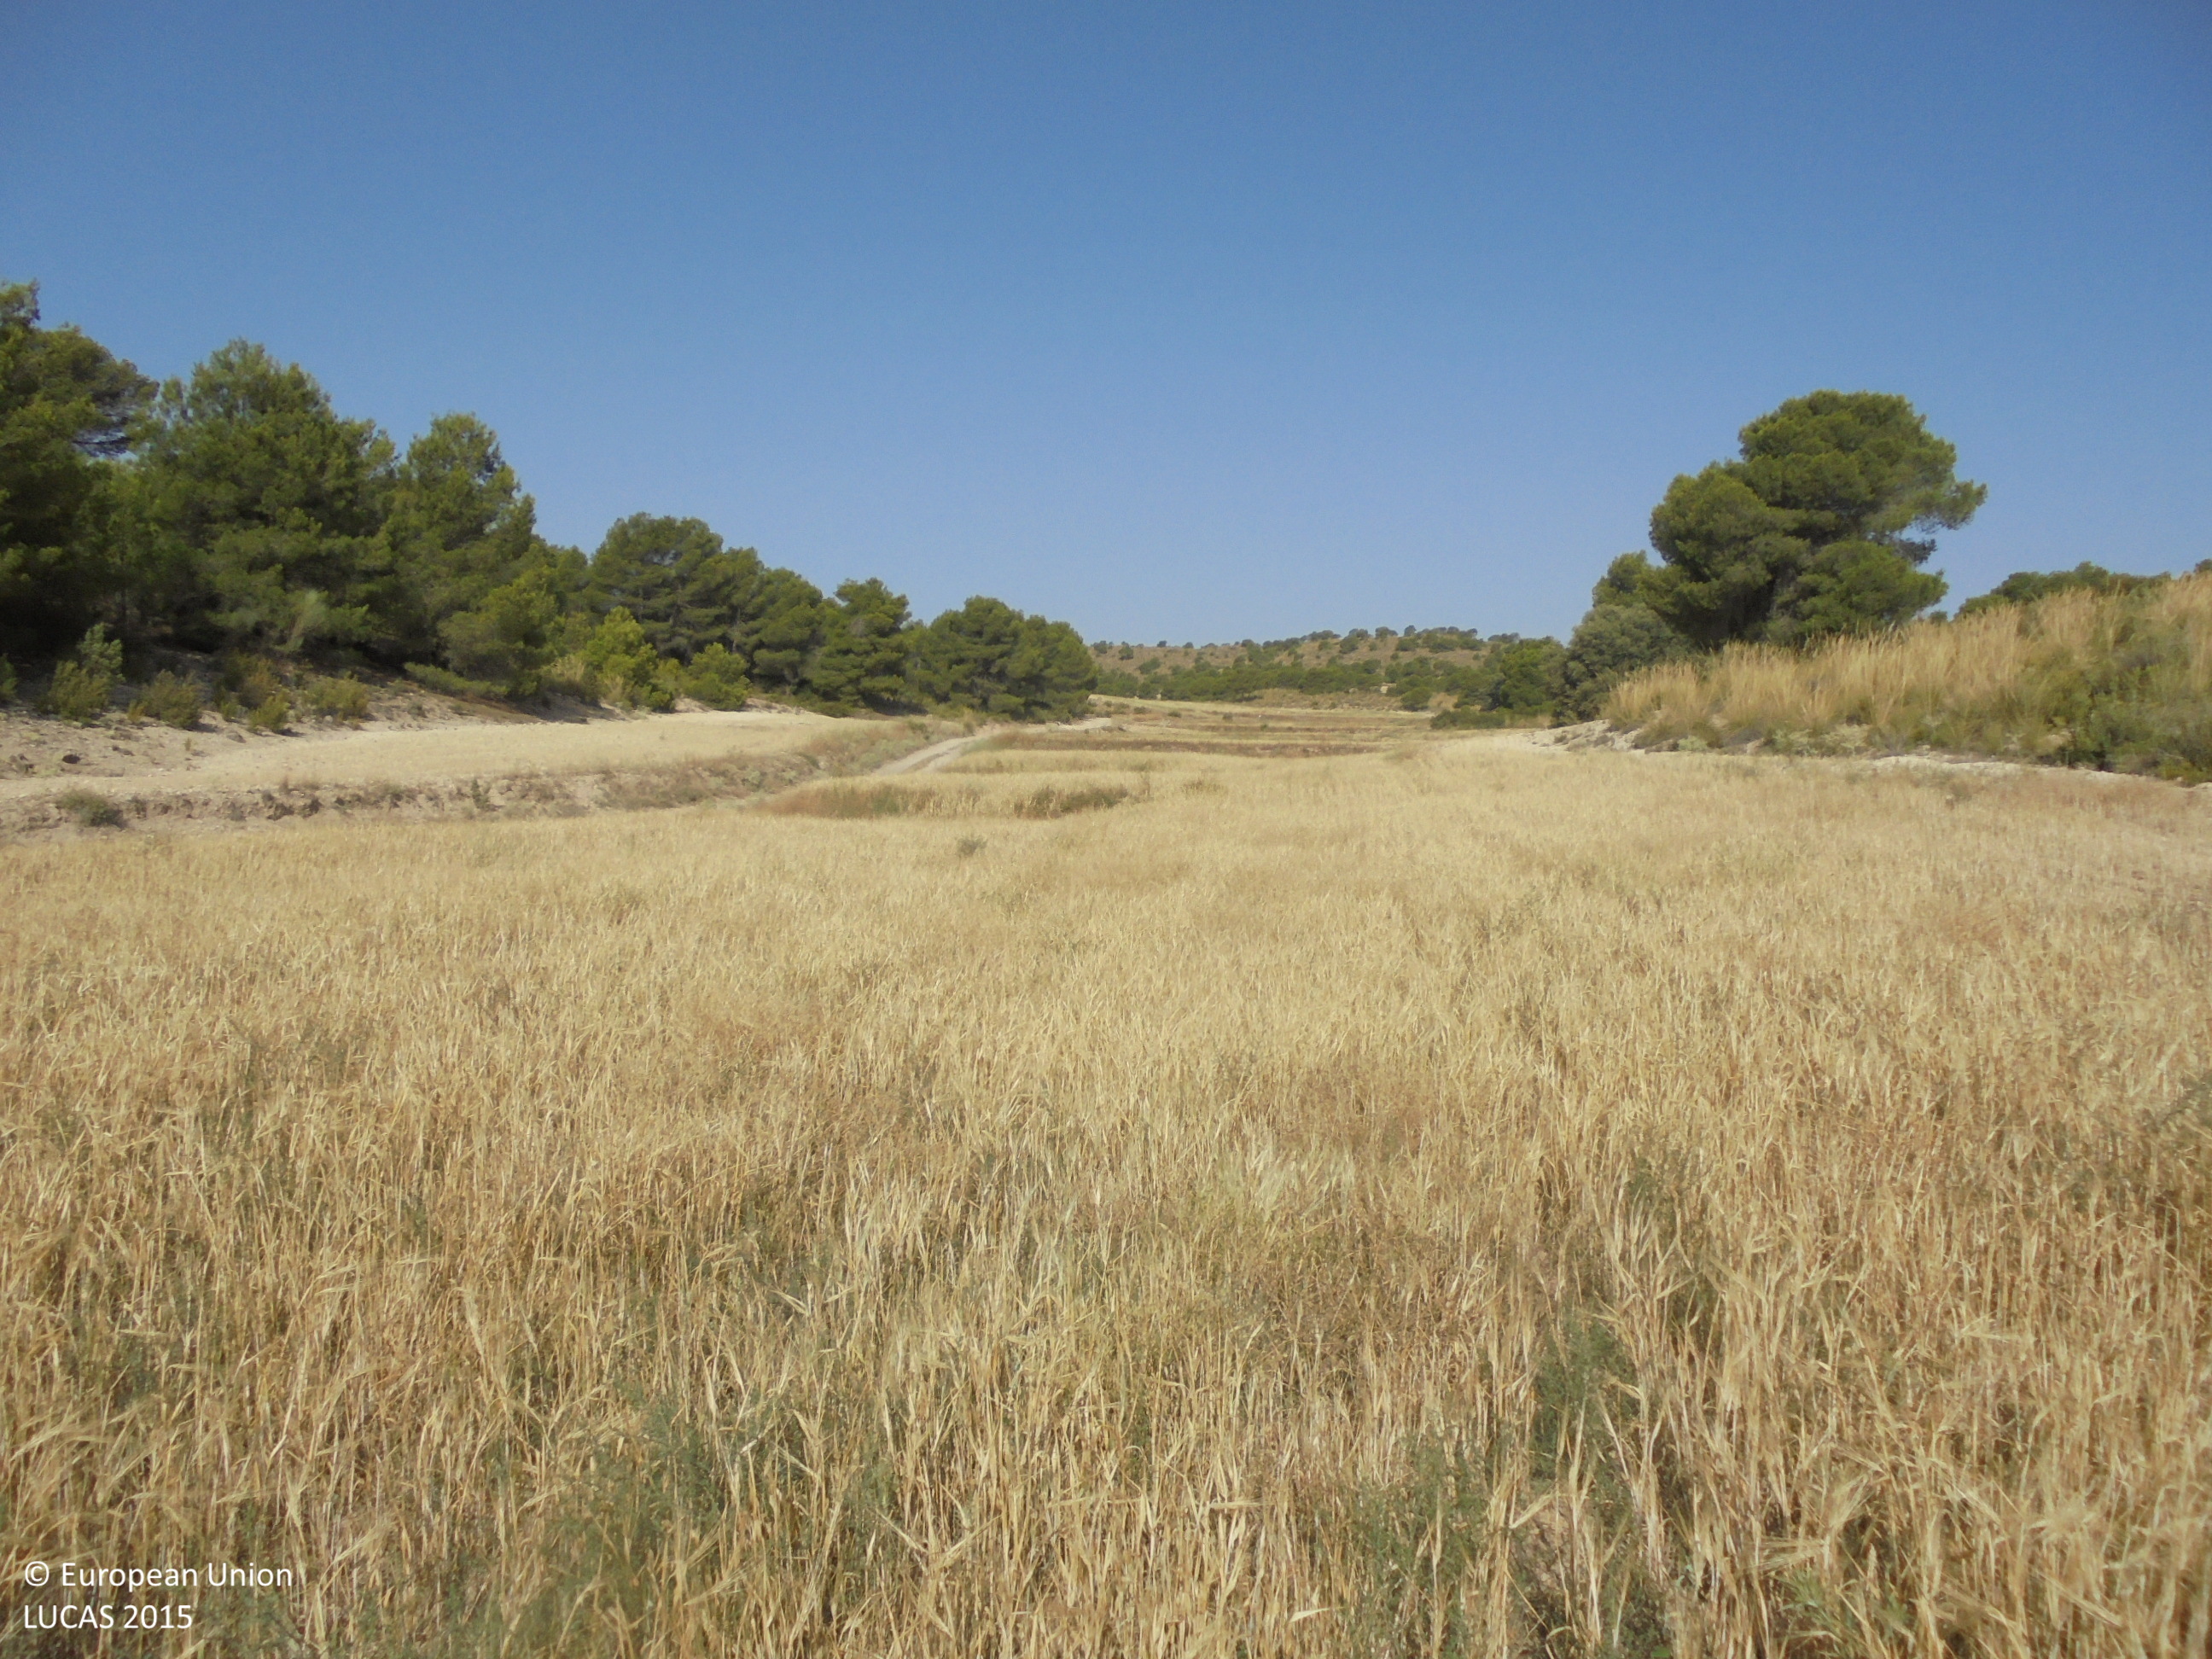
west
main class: Cropland
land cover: Barley
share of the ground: 50 - 75 %
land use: Agriculture (excluding fallow land and kitchen gardens)
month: July
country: ES
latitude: 38.6863
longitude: -1.7101
